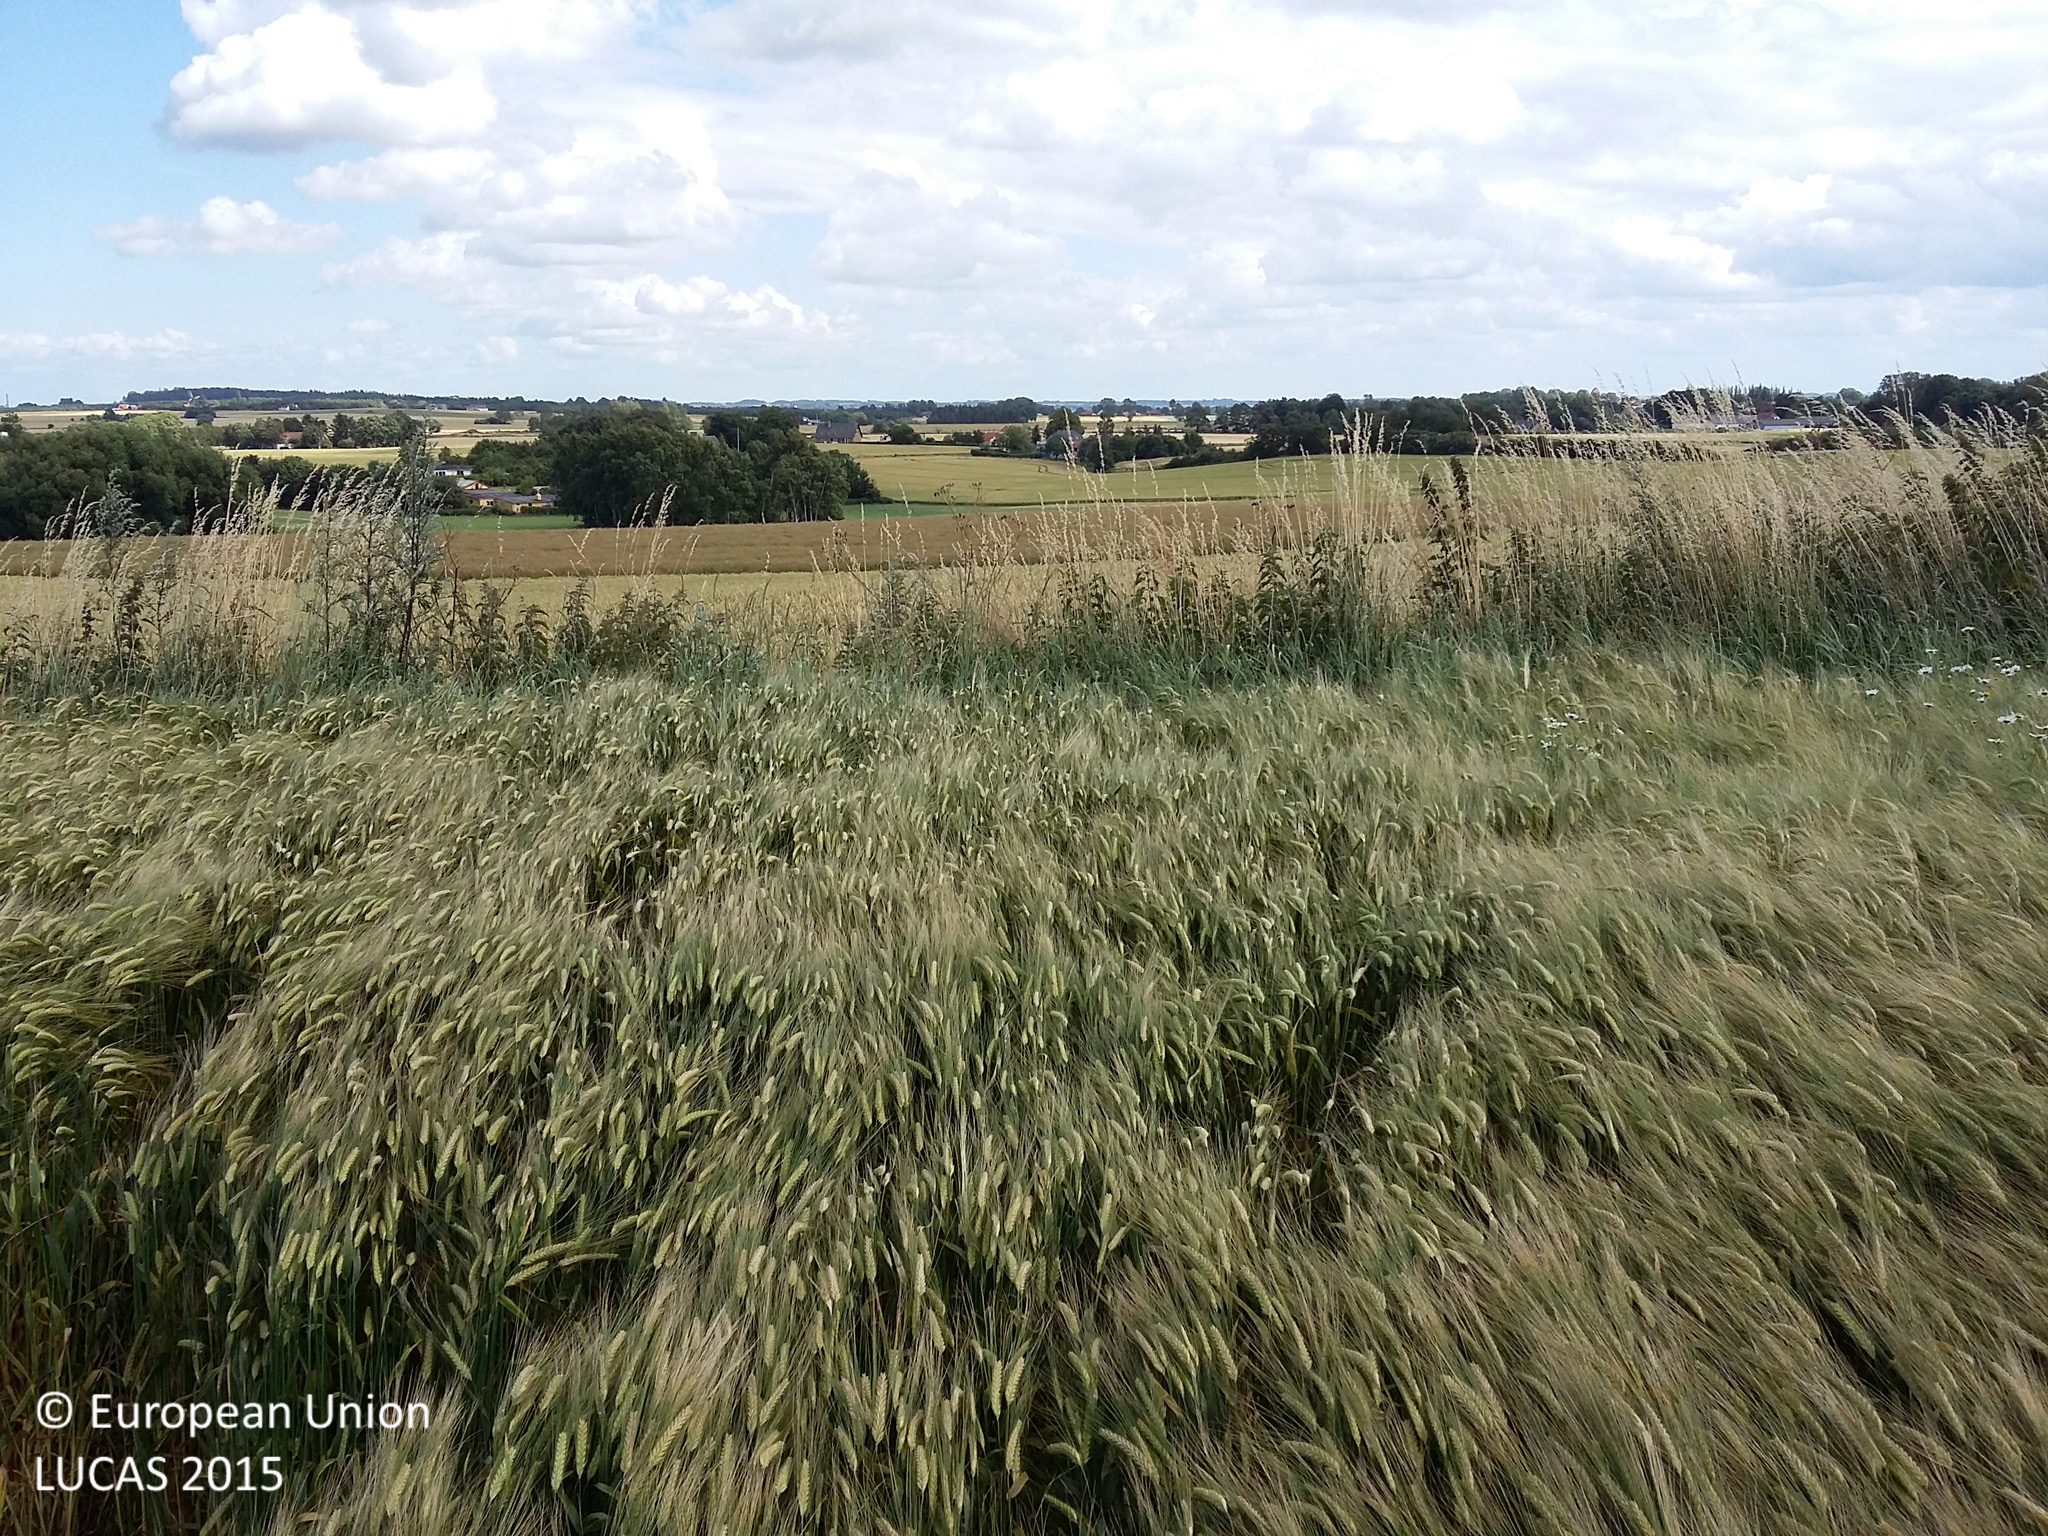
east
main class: Cropland
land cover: Barley
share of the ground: > 75 %
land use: Agriculture (excluding fallow land and kitchen gardens)
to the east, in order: Barley; Spontaneously vegetated surfaces; Common wheat; Rape and turnip rape; Common wheat
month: July
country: DK
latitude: 55.7634
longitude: 11.6718
